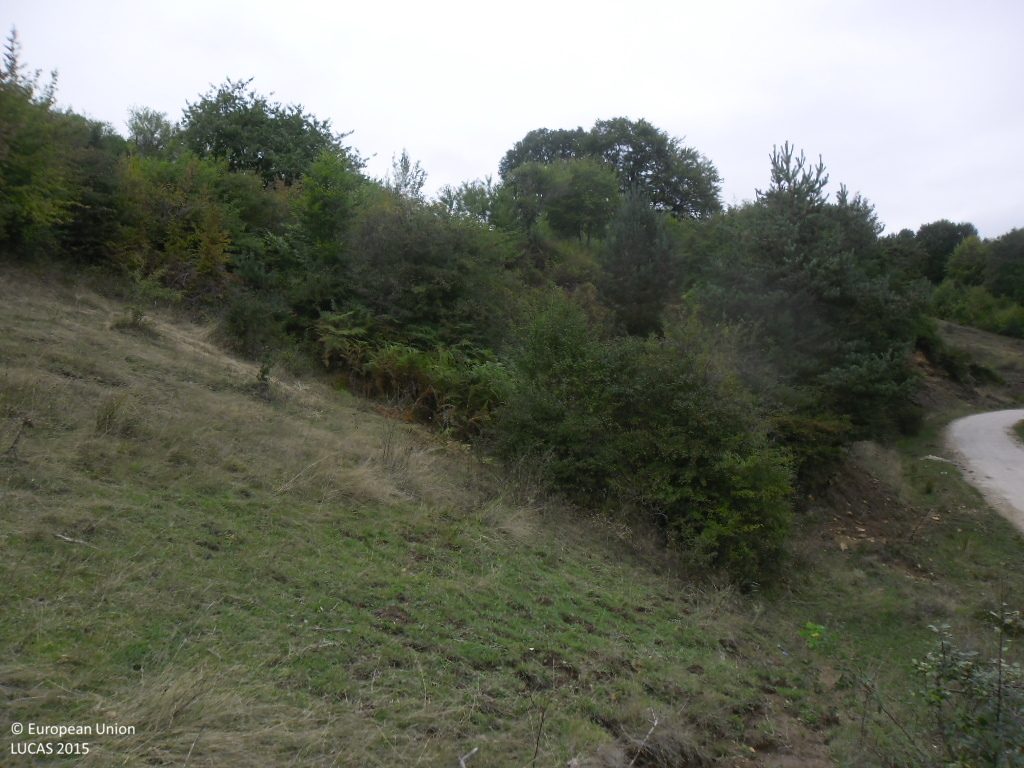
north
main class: Grassland
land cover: Grassland with sparse tree/shrub cover
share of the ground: > 75 %
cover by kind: herbaceous plants 90 %, broadleaved forest trees 5 %, shrubs 5 %
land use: Agriculture (excluding fallow land and kitchen gardens)
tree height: < 5 m
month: September
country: BG
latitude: 41.6125
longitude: 22.9909
